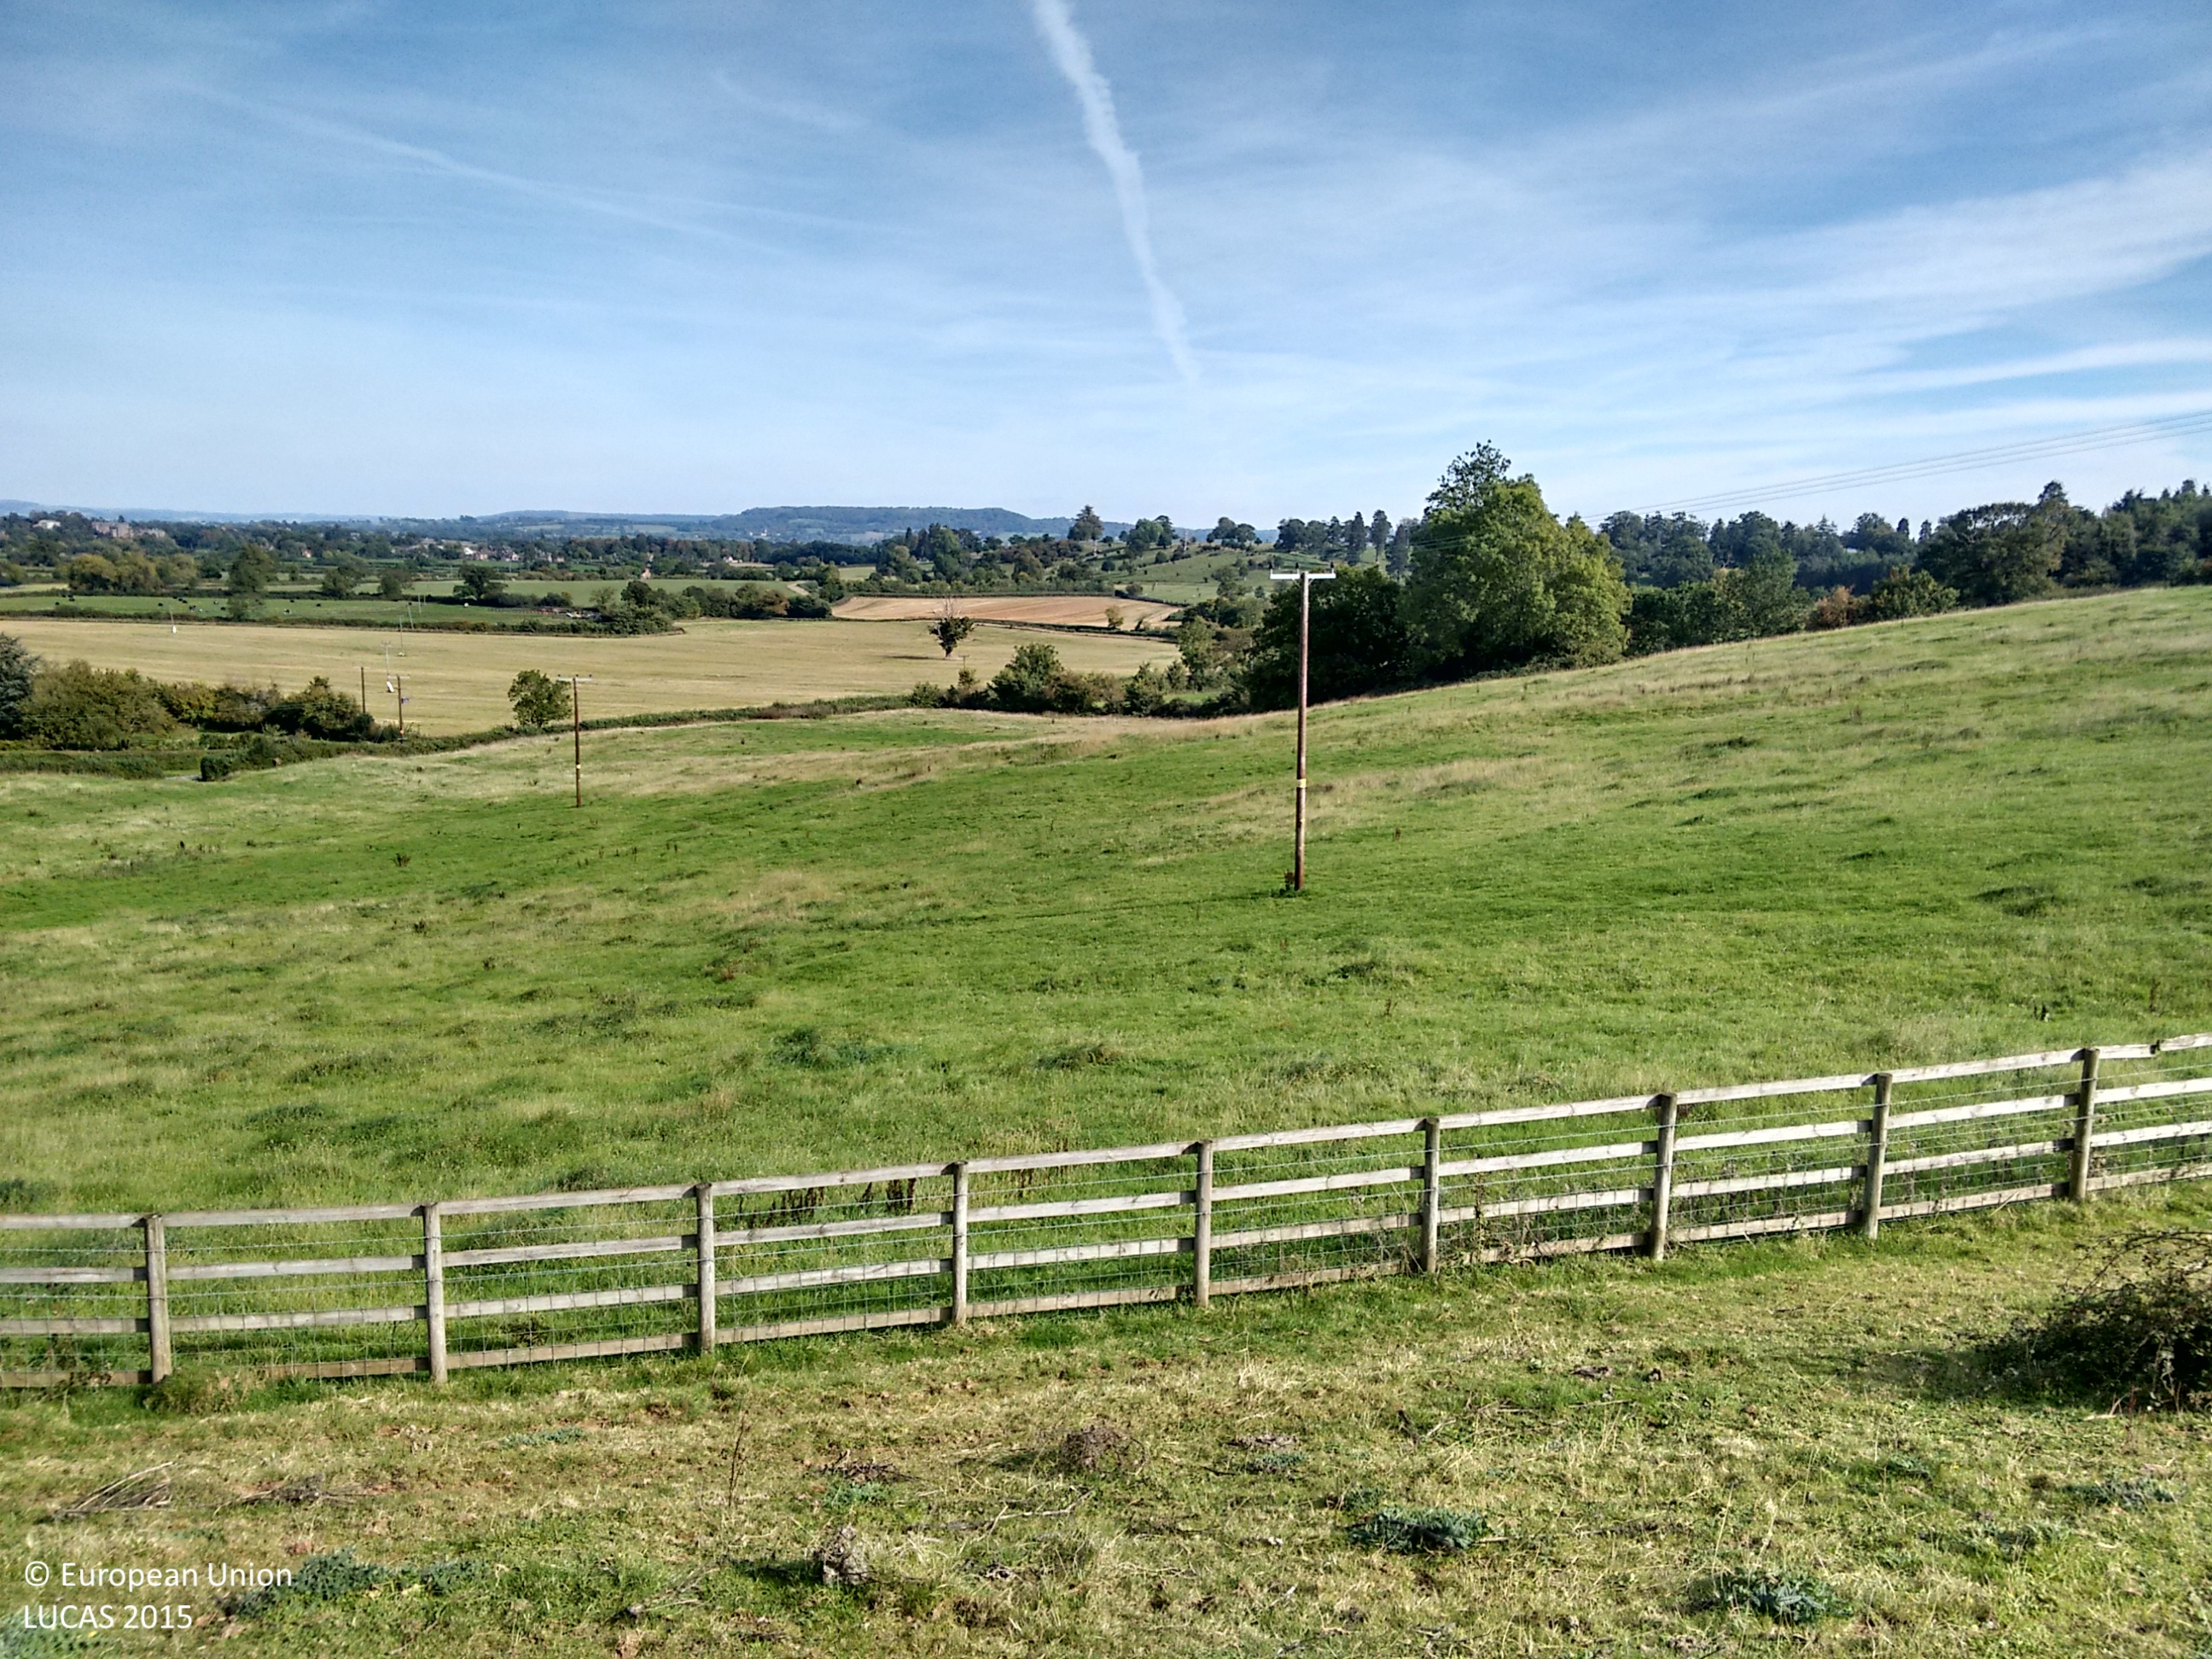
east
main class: Grassland
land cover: Grassland without tree/shrub cover
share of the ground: > 75 %
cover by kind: herbaceous plants 100 %
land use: Agriculture (excluding fallow land and kitchen gardens)
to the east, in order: Grassland without tree/shrub cover; Fences; Grassland without tree/shrub cover; Electric lines; Grassland without tree/shrub cover; Managed hedges; Fences; Grassland without tree/shrub cover
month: September
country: GB
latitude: 51.6783
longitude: -2.4893
